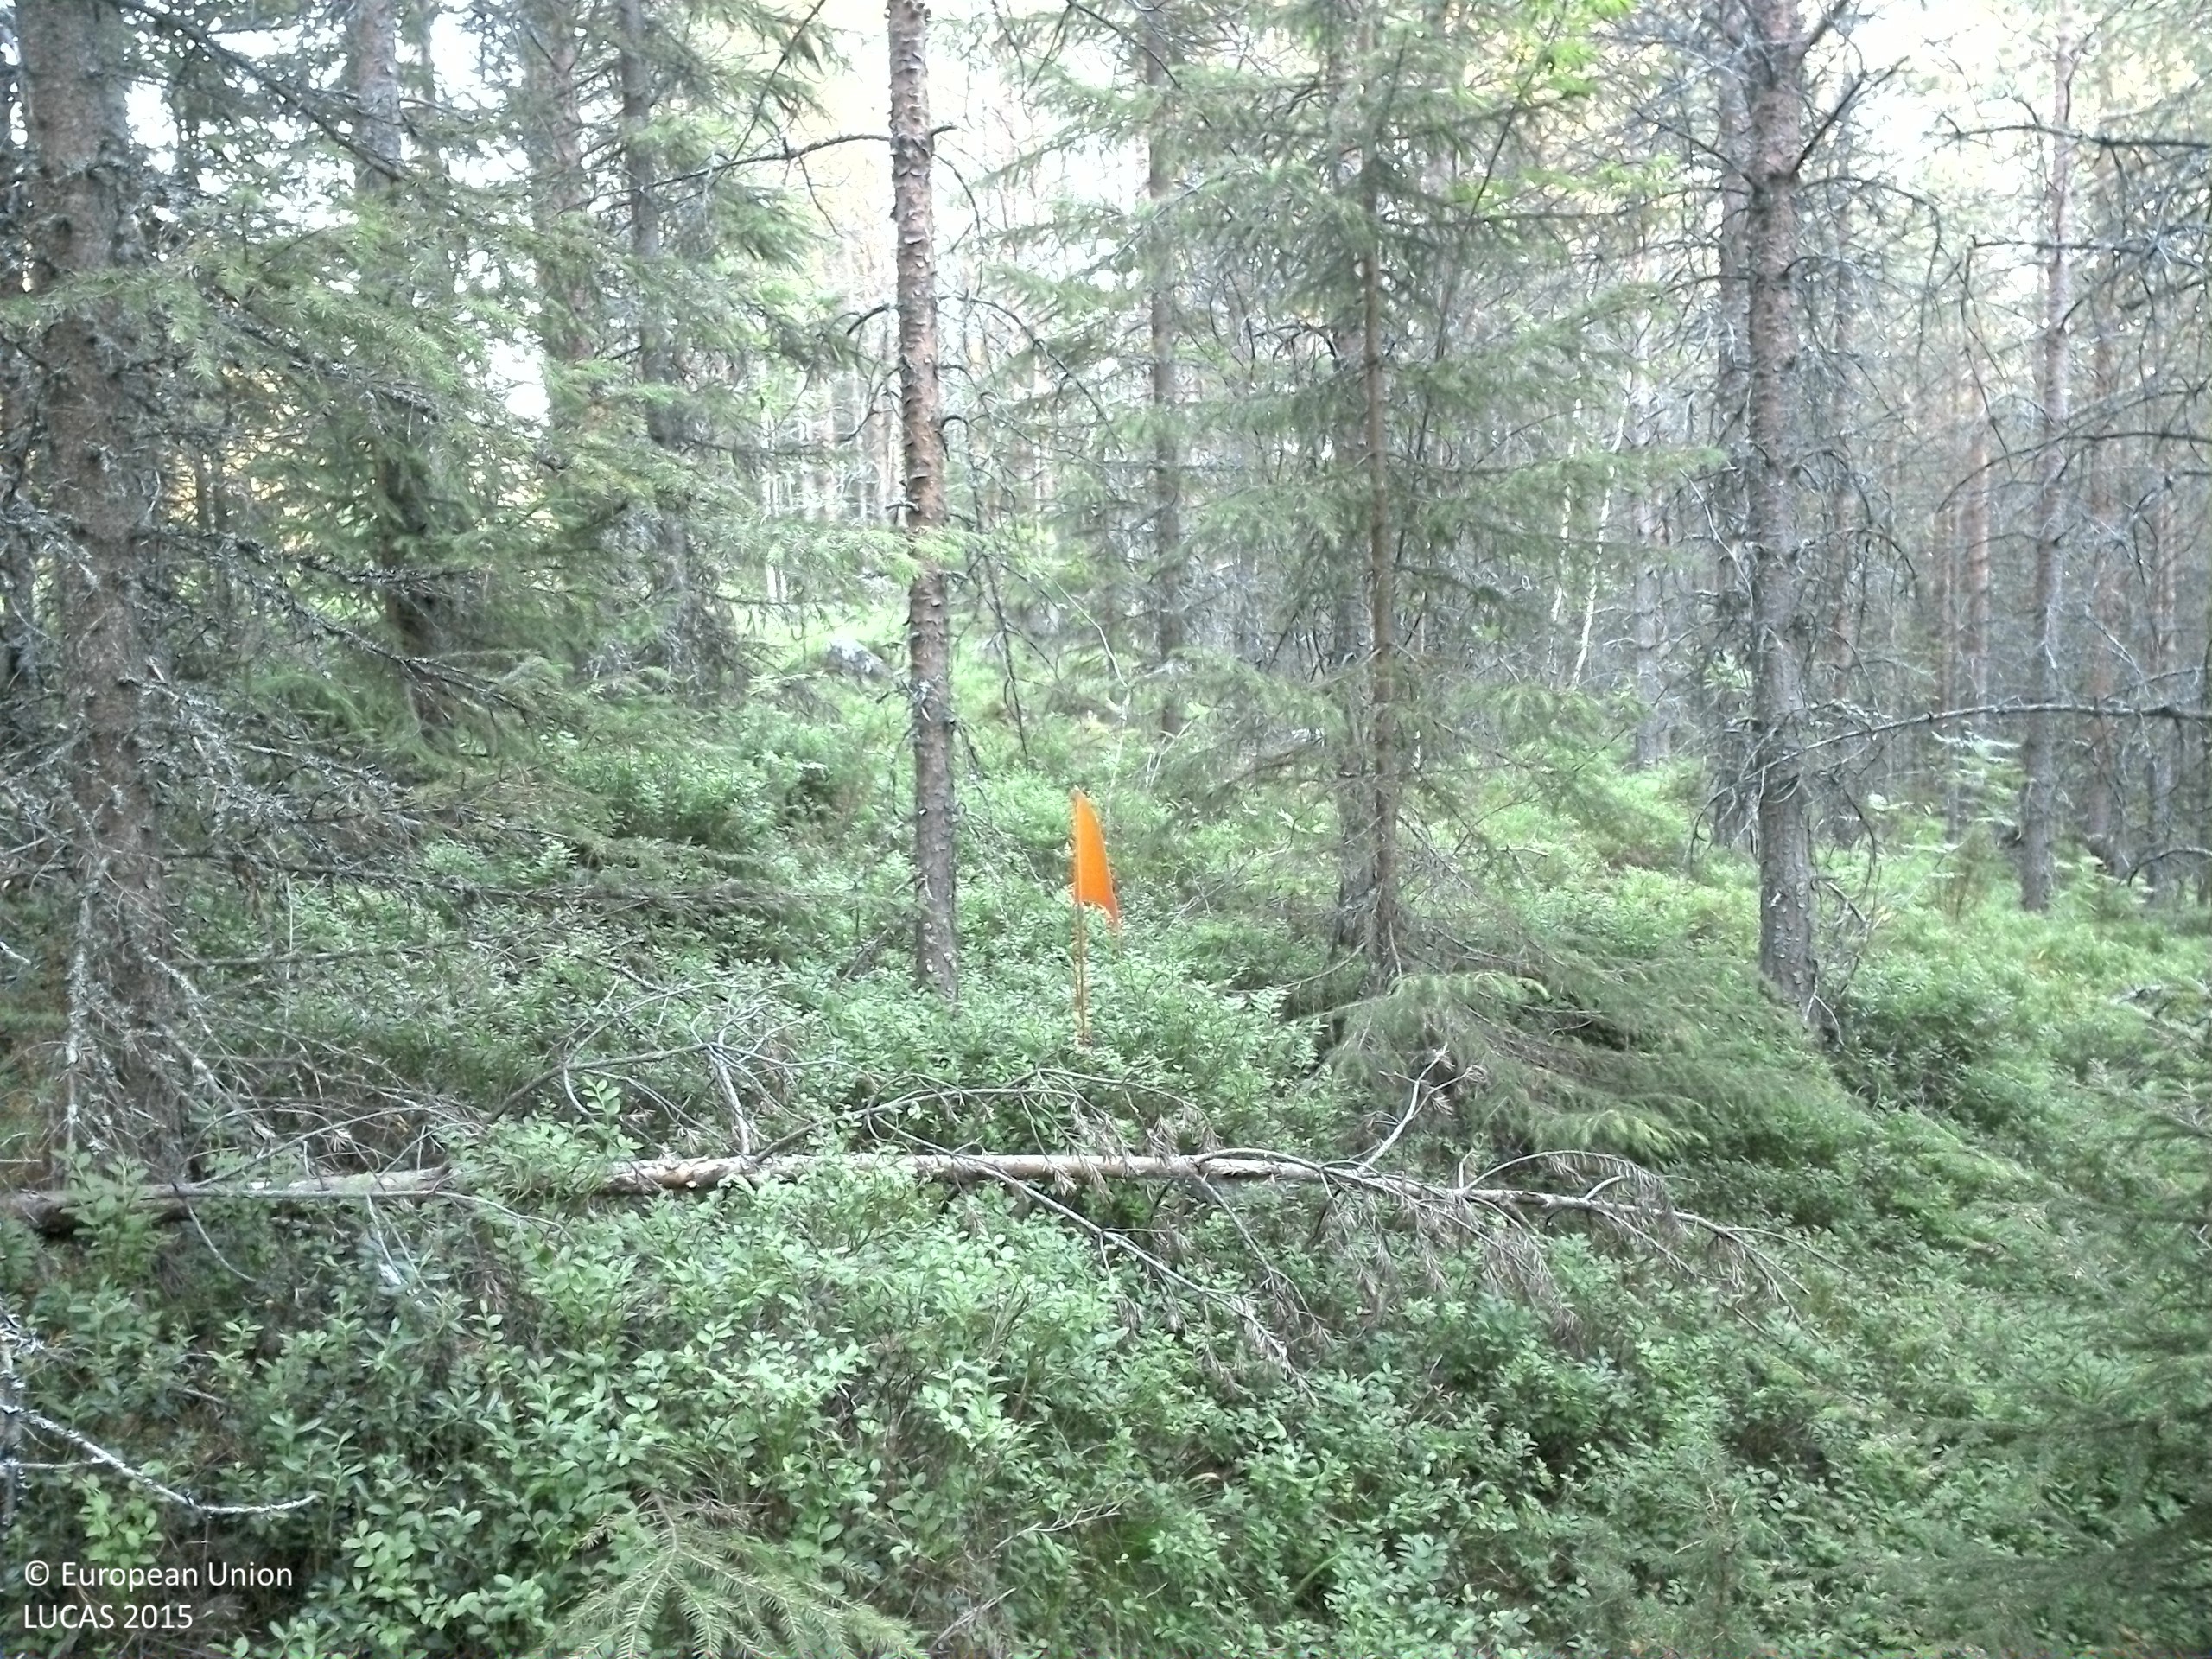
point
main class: Woodland
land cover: Pine dominated coniferous woodland
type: exotic forest
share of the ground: 50 - 75 %
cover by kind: coniferous forest trees 50 %, shrubs 45 %, broadleaved forest trees 5 %
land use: Forestry
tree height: > 5 m
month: August
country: SE
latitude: 63.7372
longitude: 17.3657
